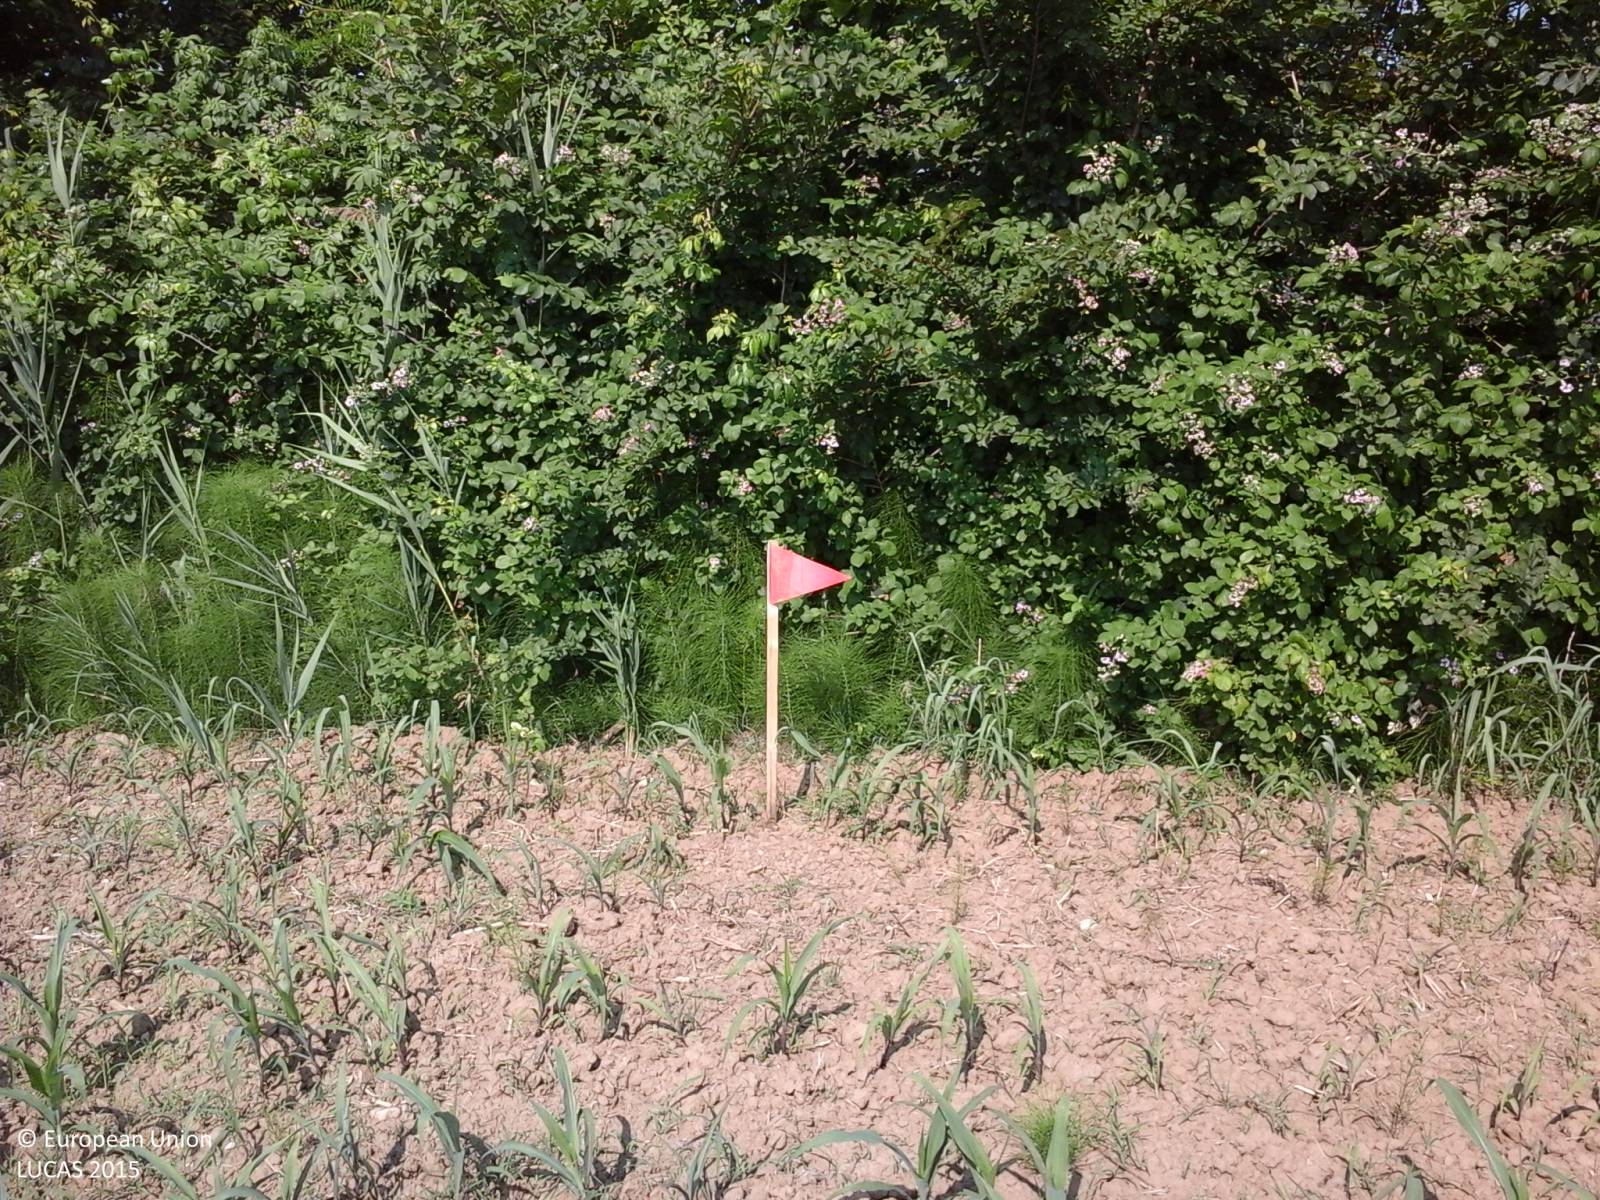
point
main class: Cropland
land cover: Maize
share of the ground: < 10 %
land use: Agriculture (excluding fallow land and kitchen gardens)
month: June
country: IT
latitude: 45.9625
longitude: 12.4614
